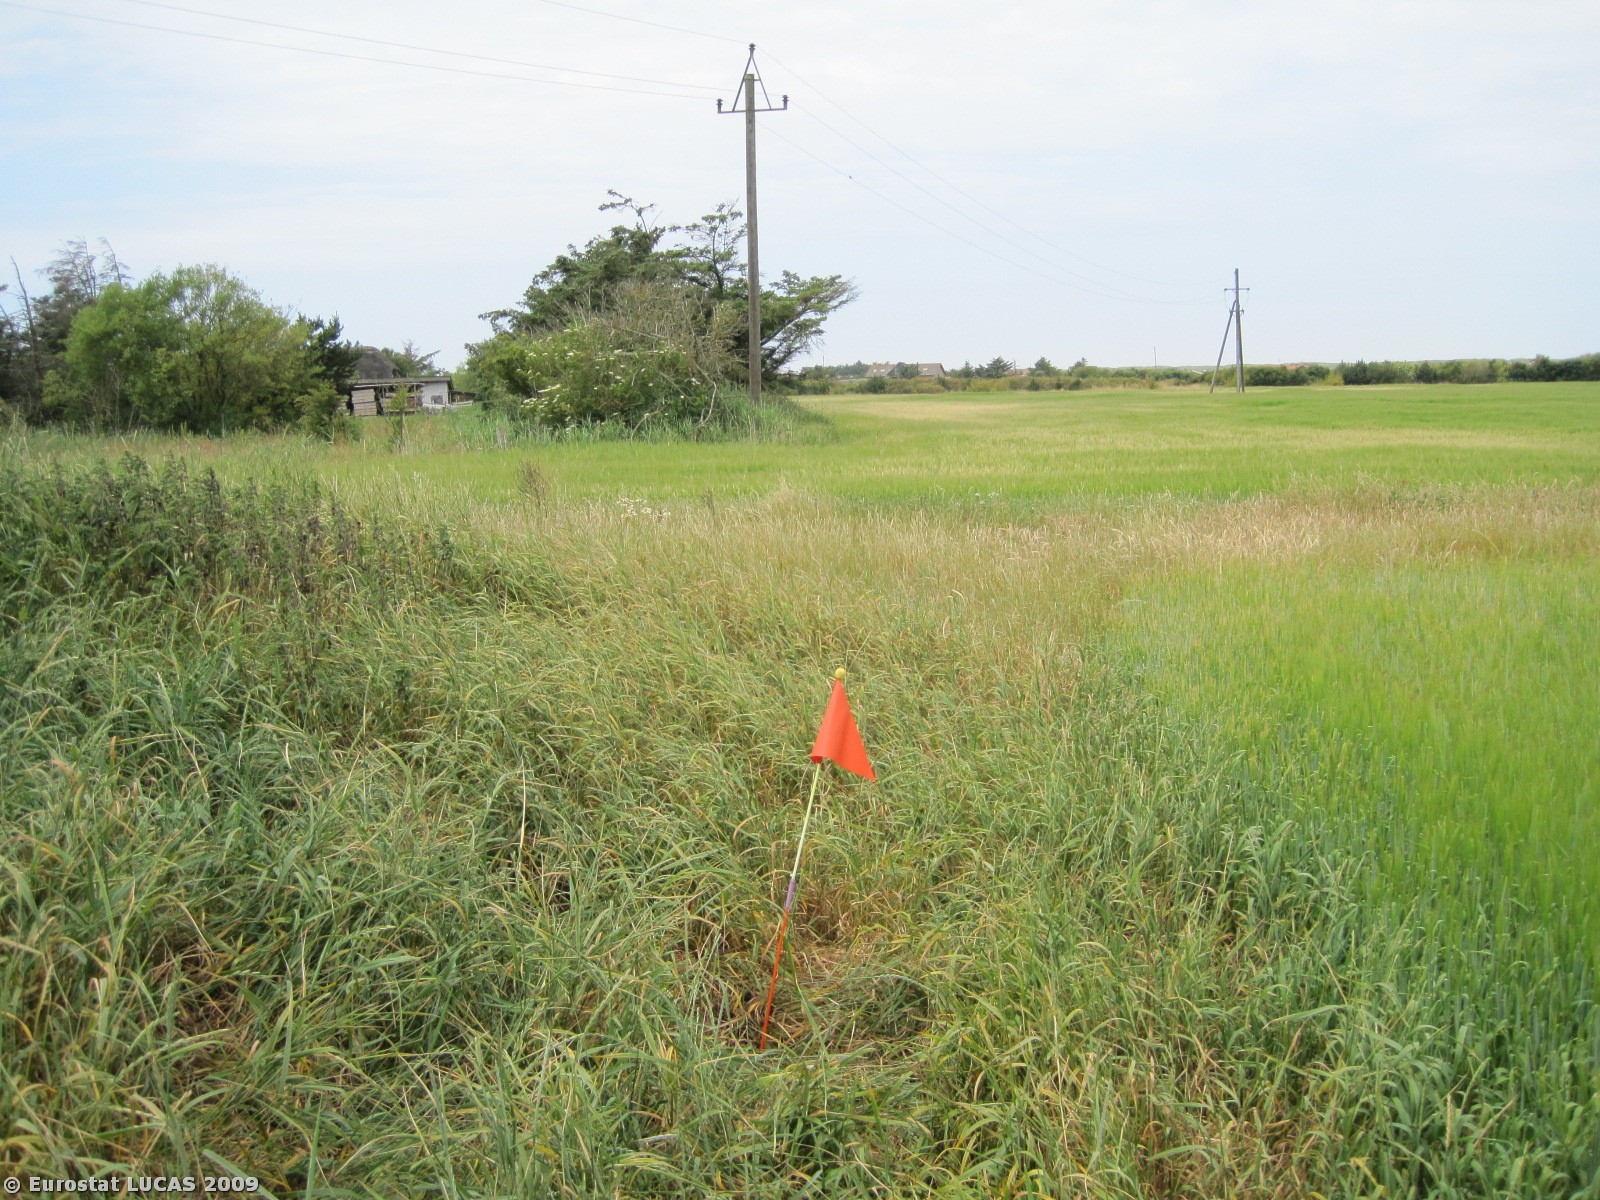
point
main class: Grassland
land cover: Grassland without tree/shrub cover
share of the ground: > 75 %
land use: Unused
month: June
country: DK
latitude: 56.6061
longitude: 8.1614
